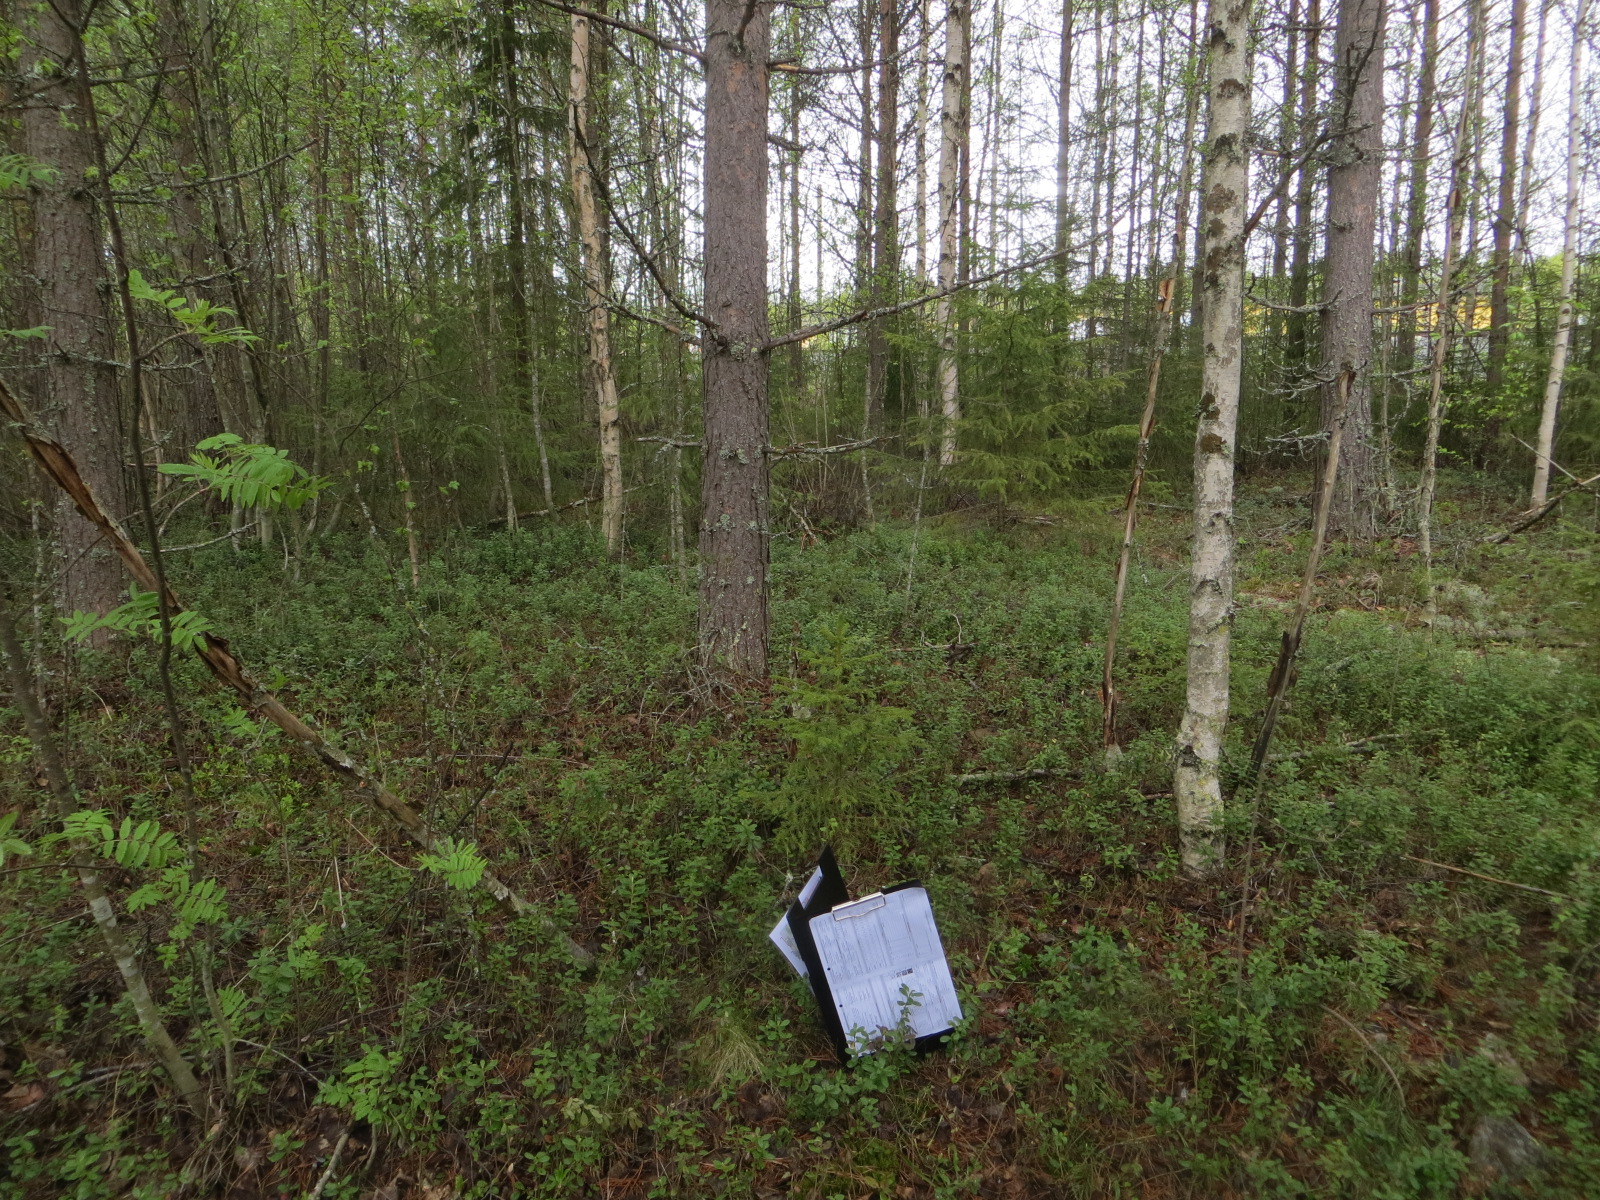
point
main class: Woodland
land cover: Other mixed woodland
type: boreal forest
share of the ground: > 75 %
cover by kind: coniferous forest trees 45 %, broadleaved forest trees 45 %, shrubs 10 %
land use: Forestry
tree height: > 5 m
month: June
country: FI
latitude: 66.5231
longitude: 25.8398
